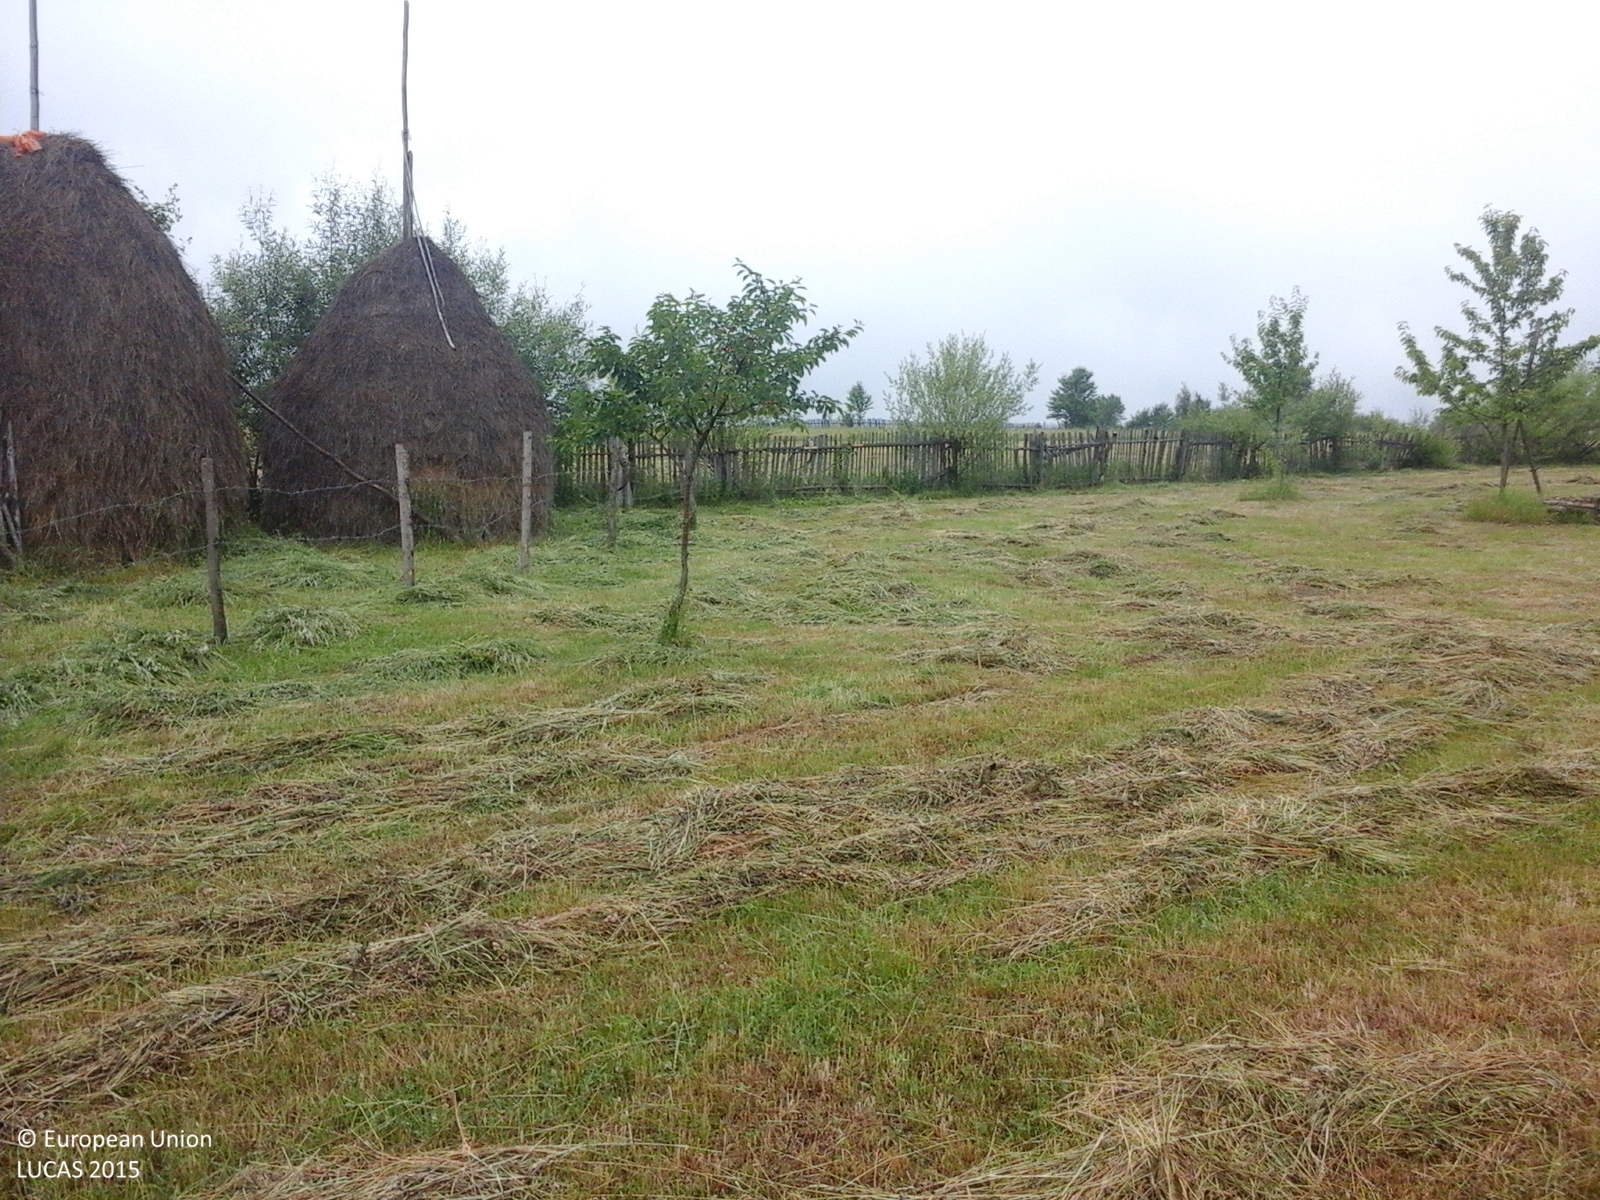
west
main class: Grassland
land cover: Grassland without tree/shrub cover
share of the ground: > 75 %
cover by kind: herbaceous plants 100 %
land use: Agriculture (excluding fallow land and kitchen gardens)
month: June
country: RO
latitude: 47.3175
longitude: 26.2610
